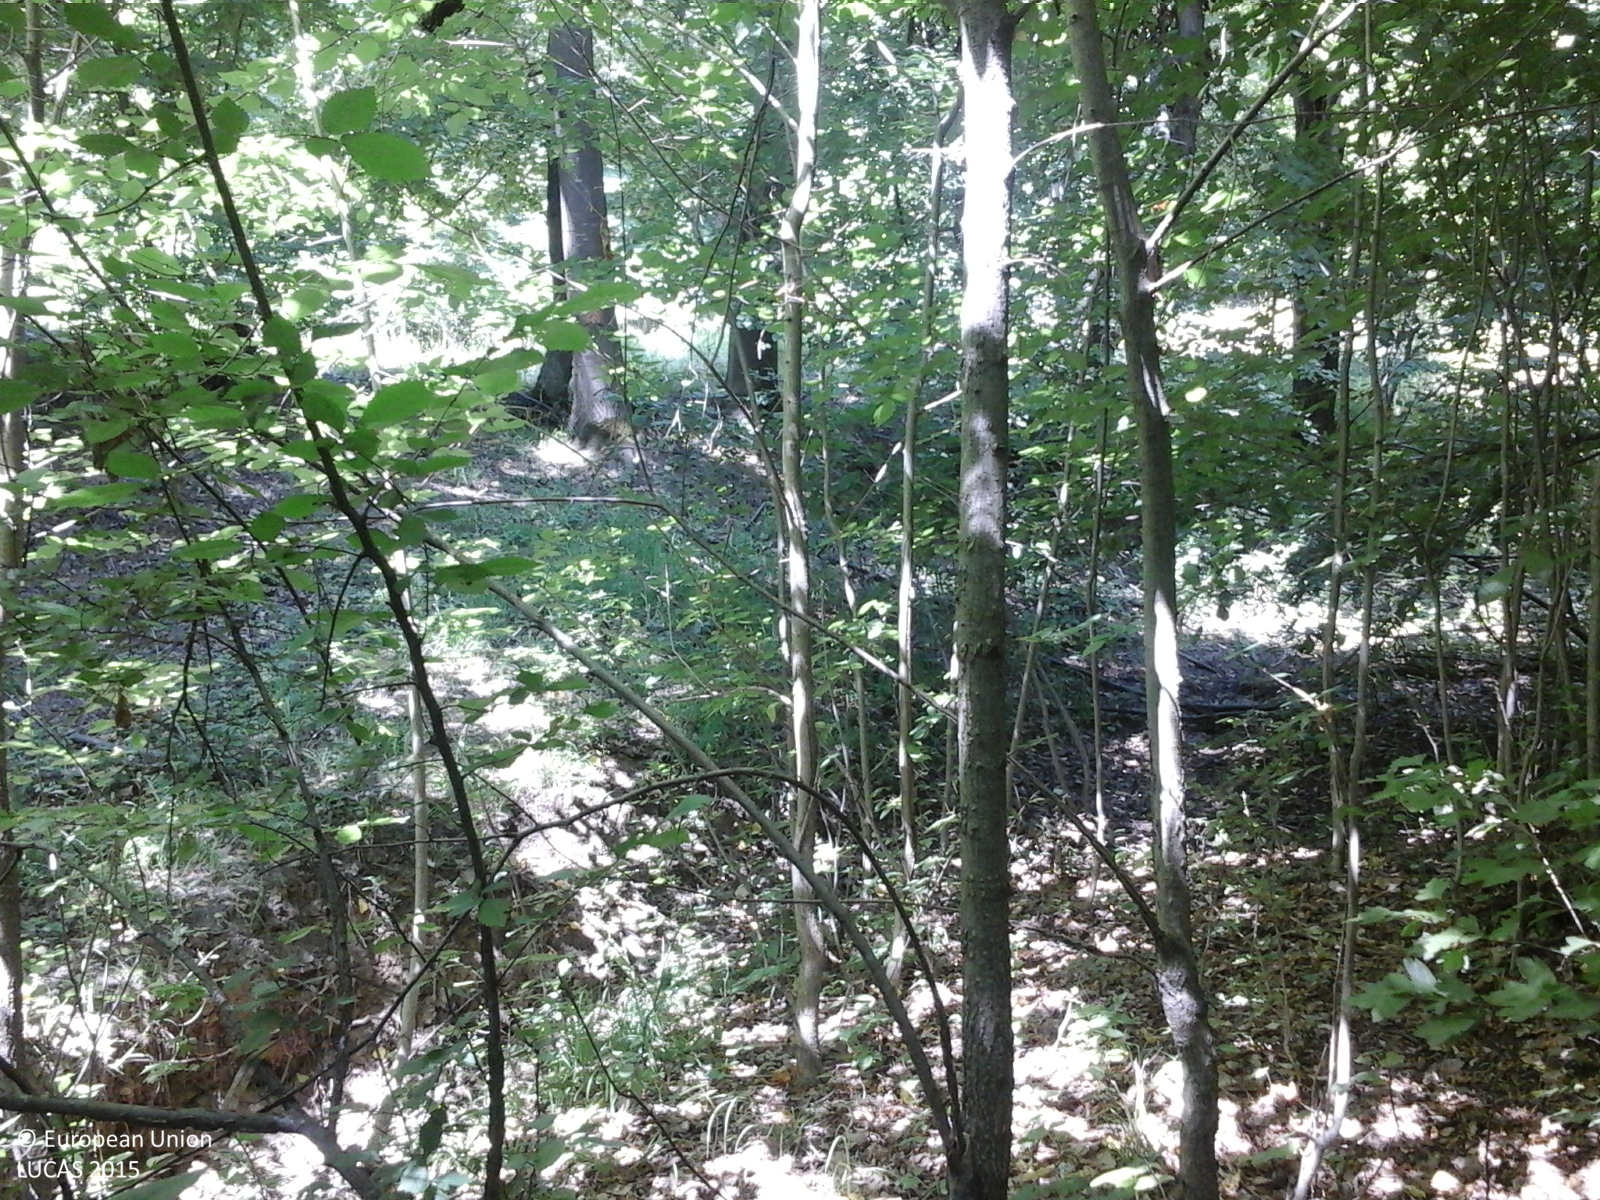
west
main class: Woodland
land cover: Broadleaved woodland
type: mesophytic deciduous forest
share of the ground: > 75 %
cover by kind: broadleaved forest trees 100 %
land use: Forestry
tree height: > 5 m
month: June
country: RO
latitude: 47.0873
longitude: 27.5983
